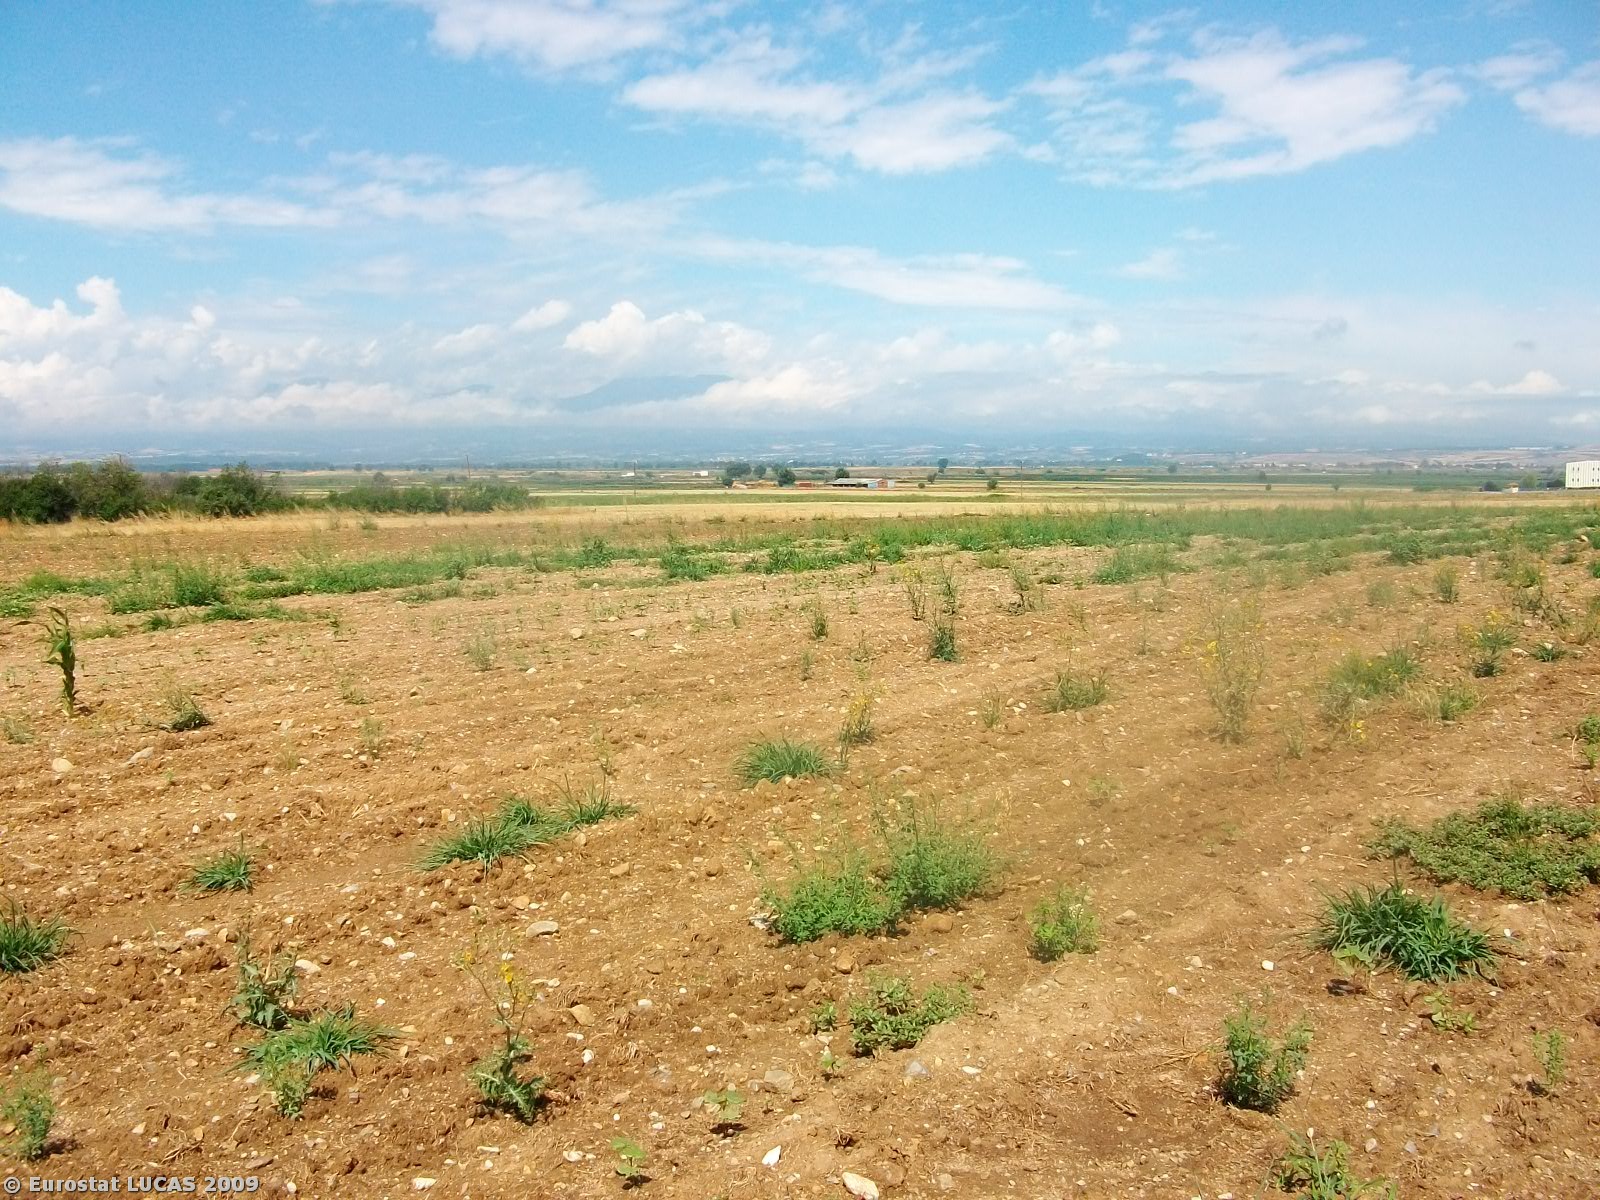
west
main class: Cropland
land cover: Cotton
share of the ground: < 10 %
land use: Agriculture (excluding fallow land and kitchen gardens)
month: June
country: GR
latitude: 40.9609
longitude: 22.6614
